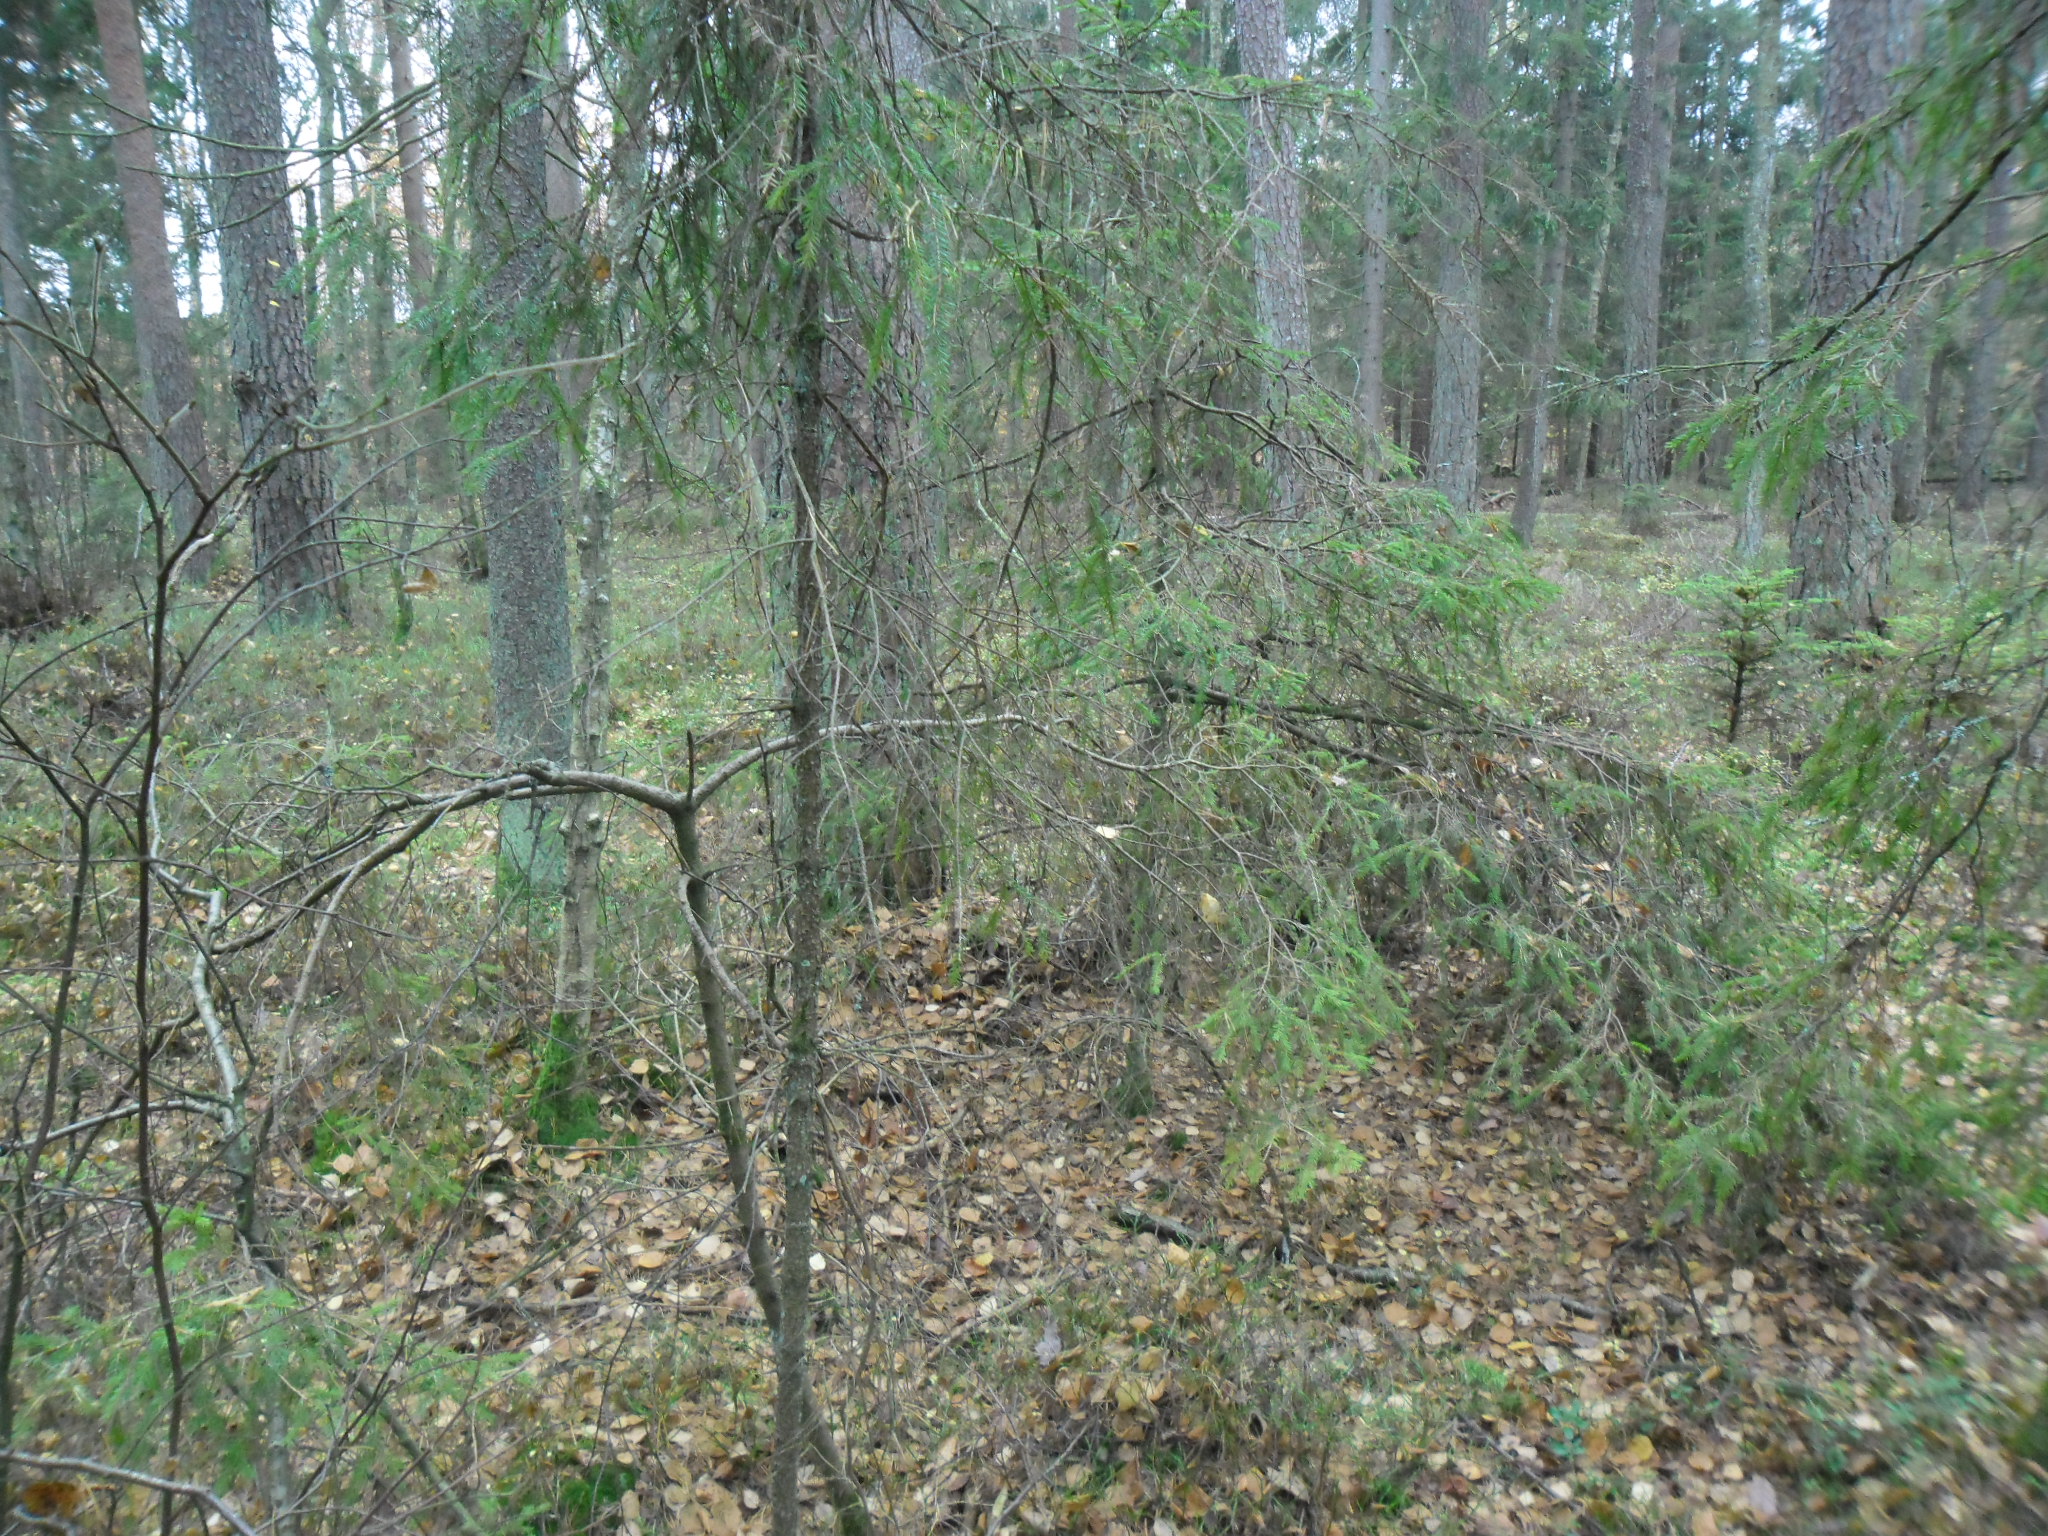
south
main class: Woodland
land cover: Pine dominated mixed woodland
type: boreal forest
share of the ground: > 75 %
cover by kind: coniferous forest trees 60 %, broadleaved forest trees 20 %, shrubs 20 %
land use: Forestry
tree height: > 5 m
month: November
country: SE
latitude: 56.3126
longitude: 13.0849
